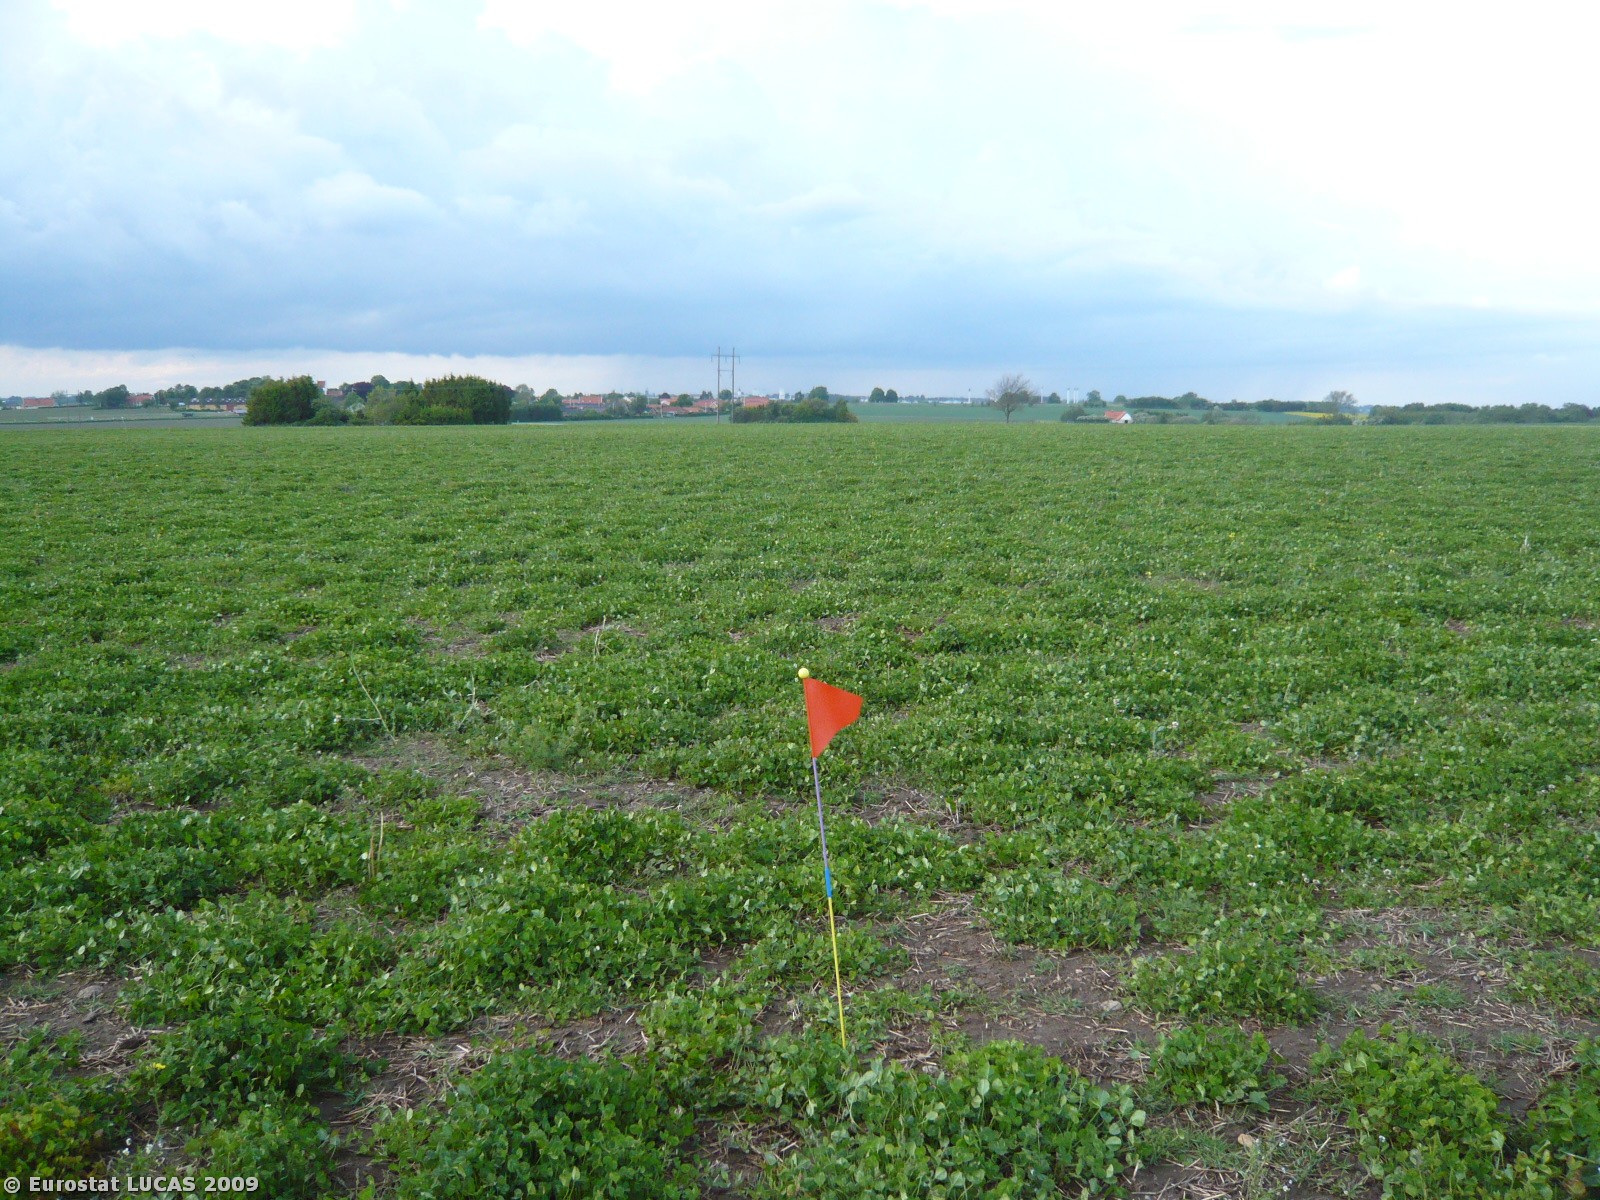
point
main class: Cropland
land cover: Clovers
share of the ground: > 75 %
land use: Agriculture (excluding fallow land and kitchen gardens)
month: May
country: DK
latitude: 55.4023
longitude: 11.7830
